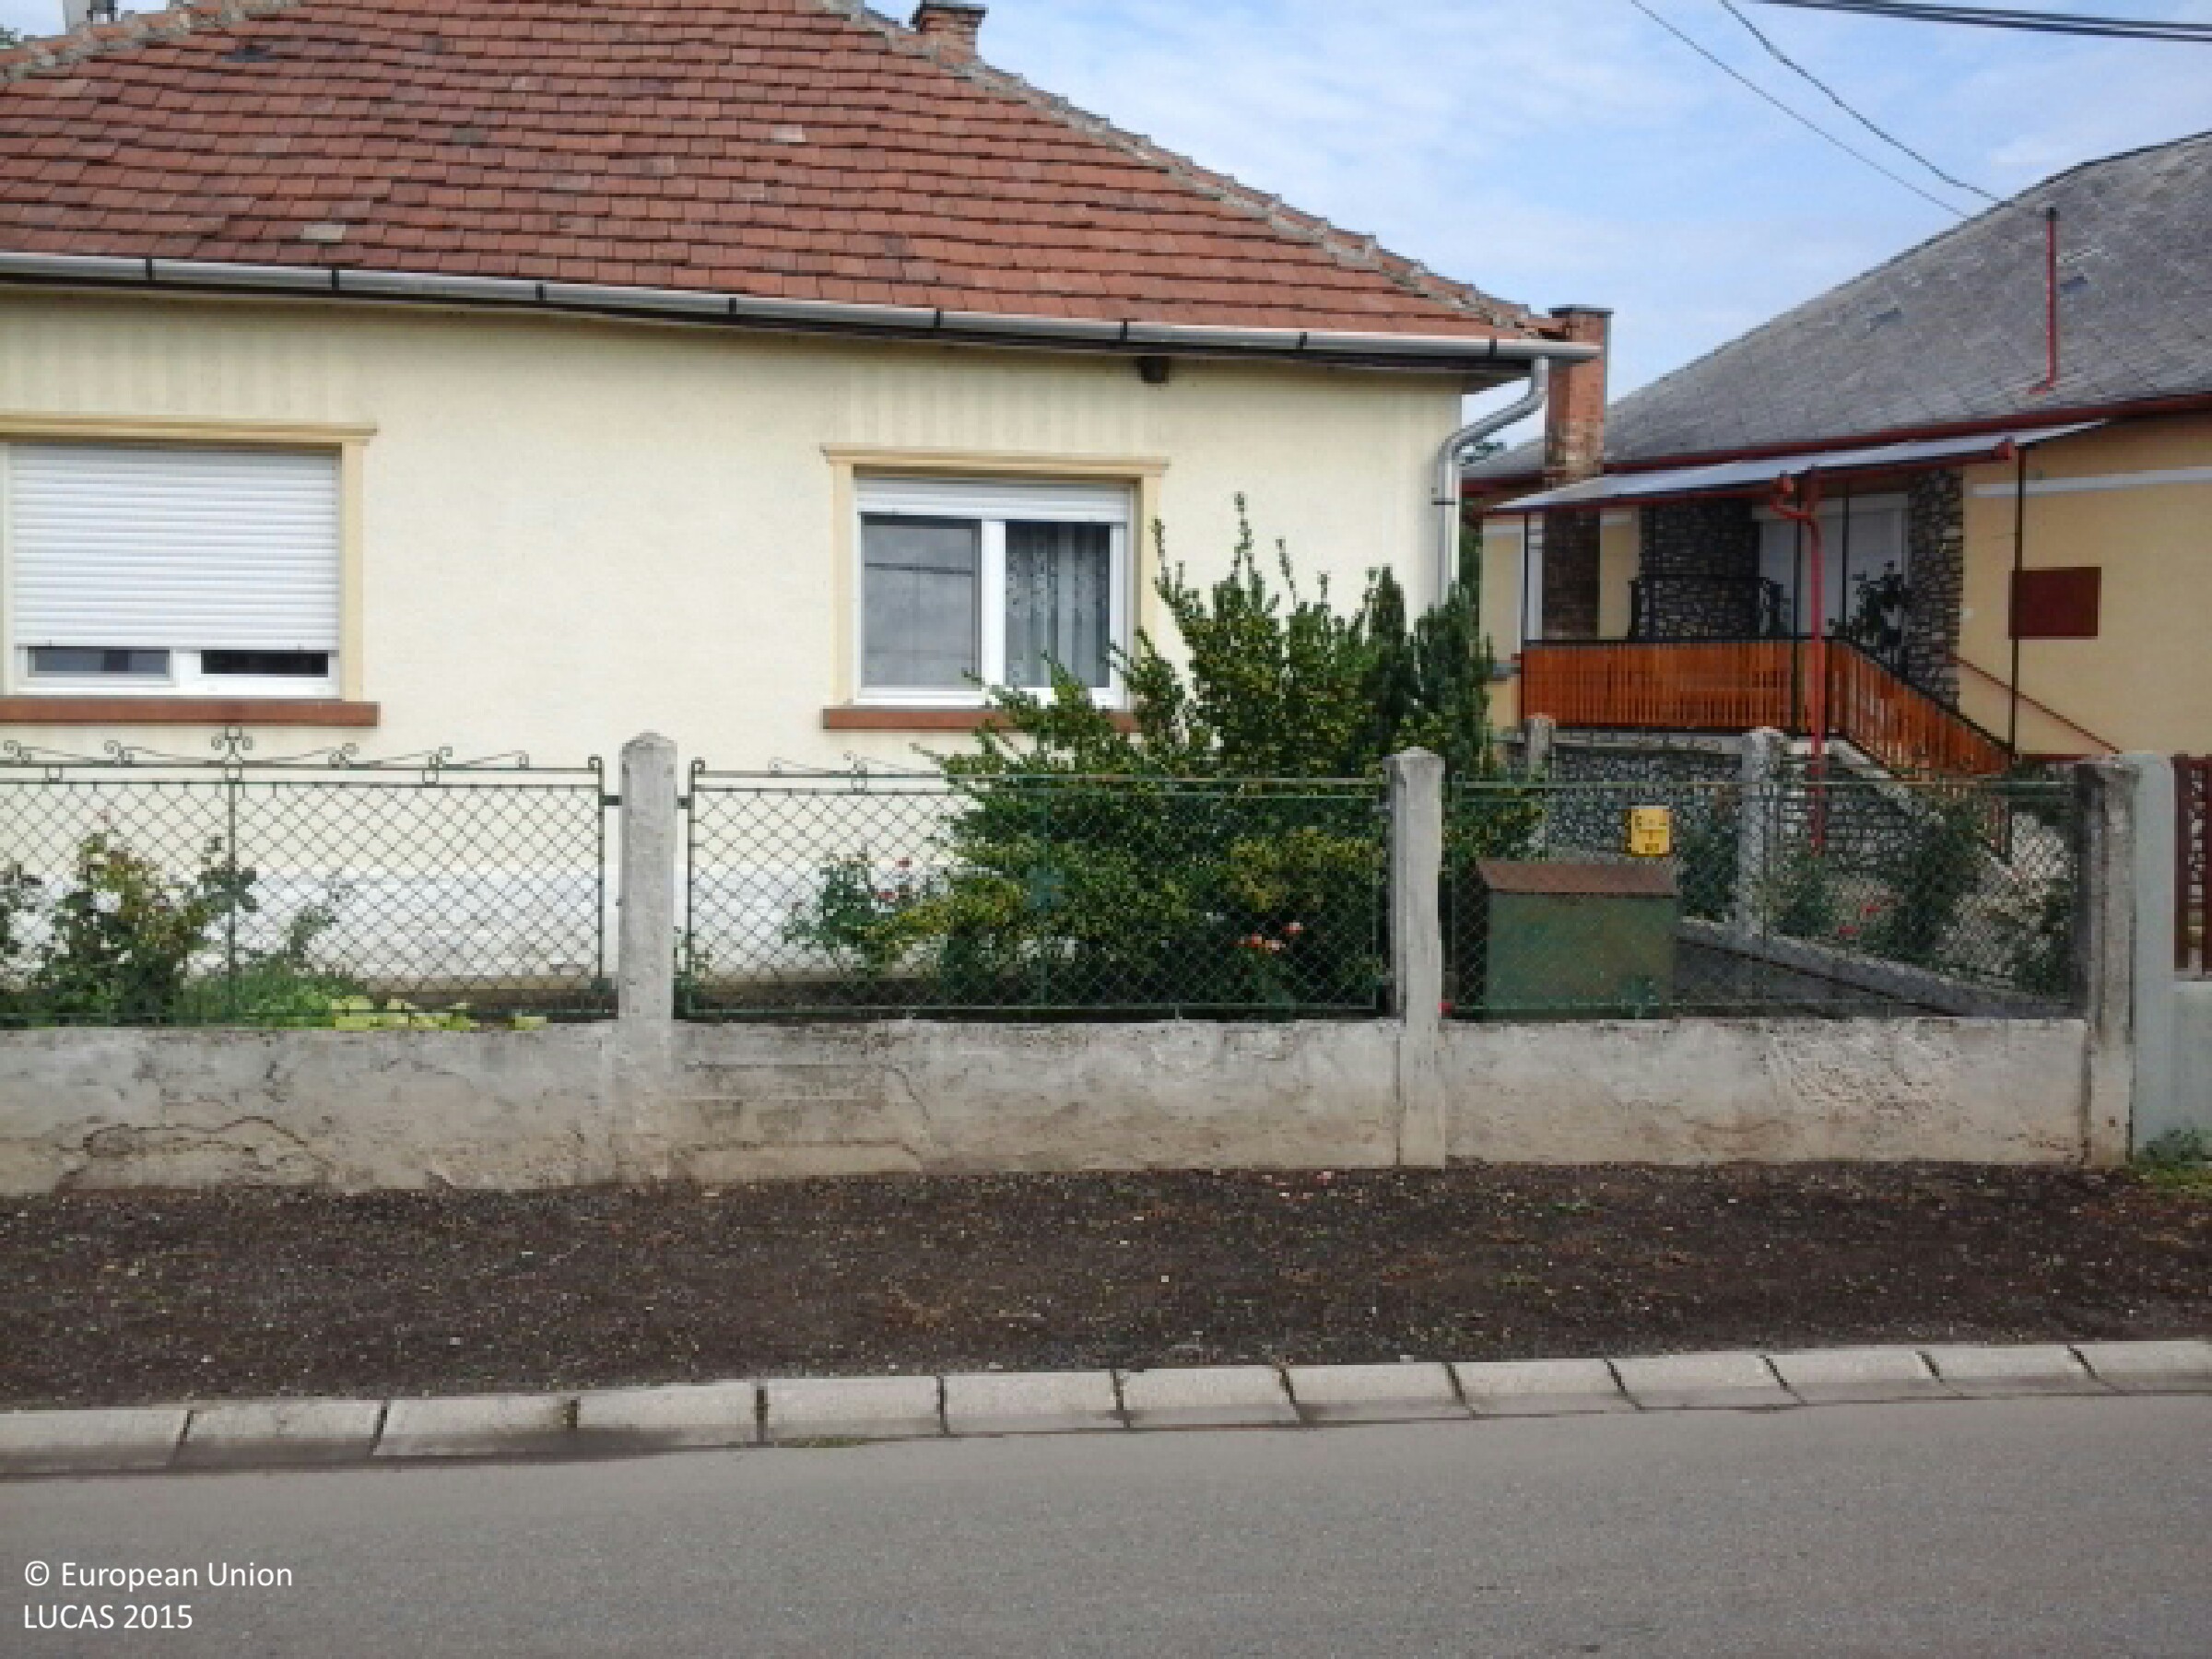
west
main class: Grassland
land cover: Grassland without tree/shrub cover
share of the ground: > 75 %
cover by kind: herbaceous plants 100 %
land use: Residential
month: July
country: HU
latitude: 48.2054
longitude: 20.9246
